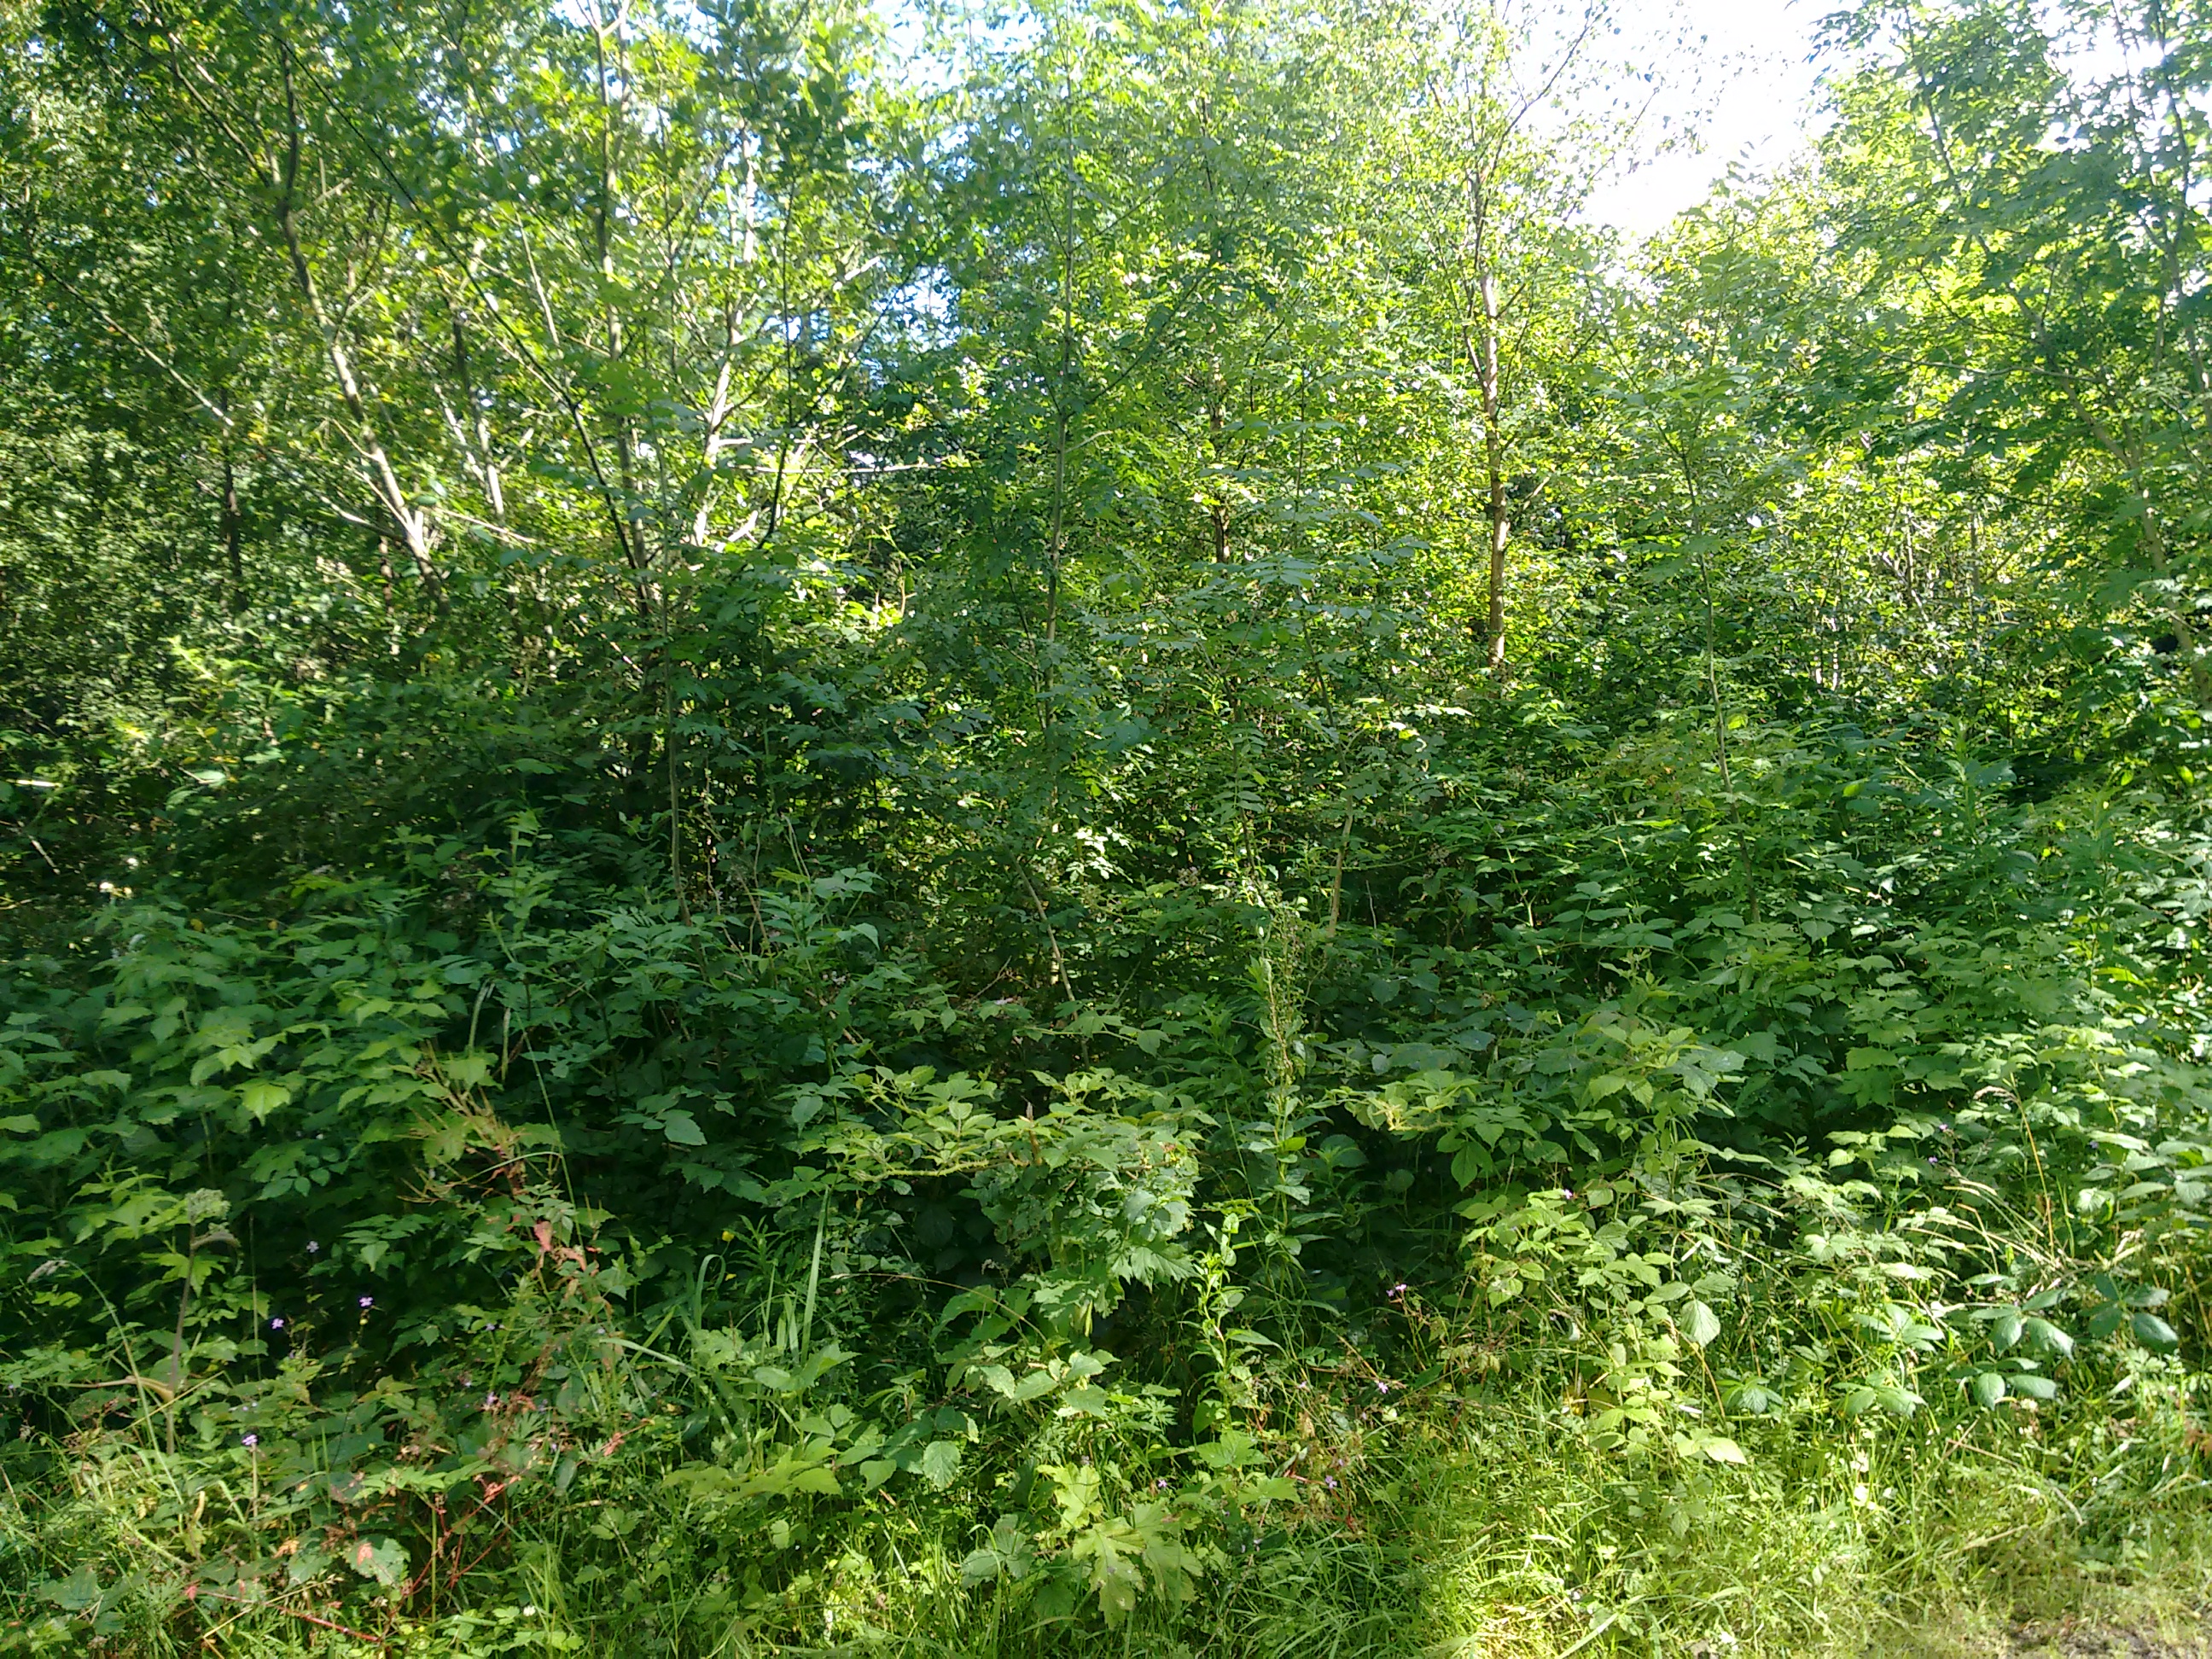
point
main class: Woodland
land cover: Other mixed woodland
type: exotic forest
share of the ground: > 75 %
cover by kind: coniferous forest trees 75 %, broadleaved forest trees 25 %
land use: Forestry
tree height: > 5 m
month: August
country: GB
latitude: 54.4764
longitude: -6.8164
